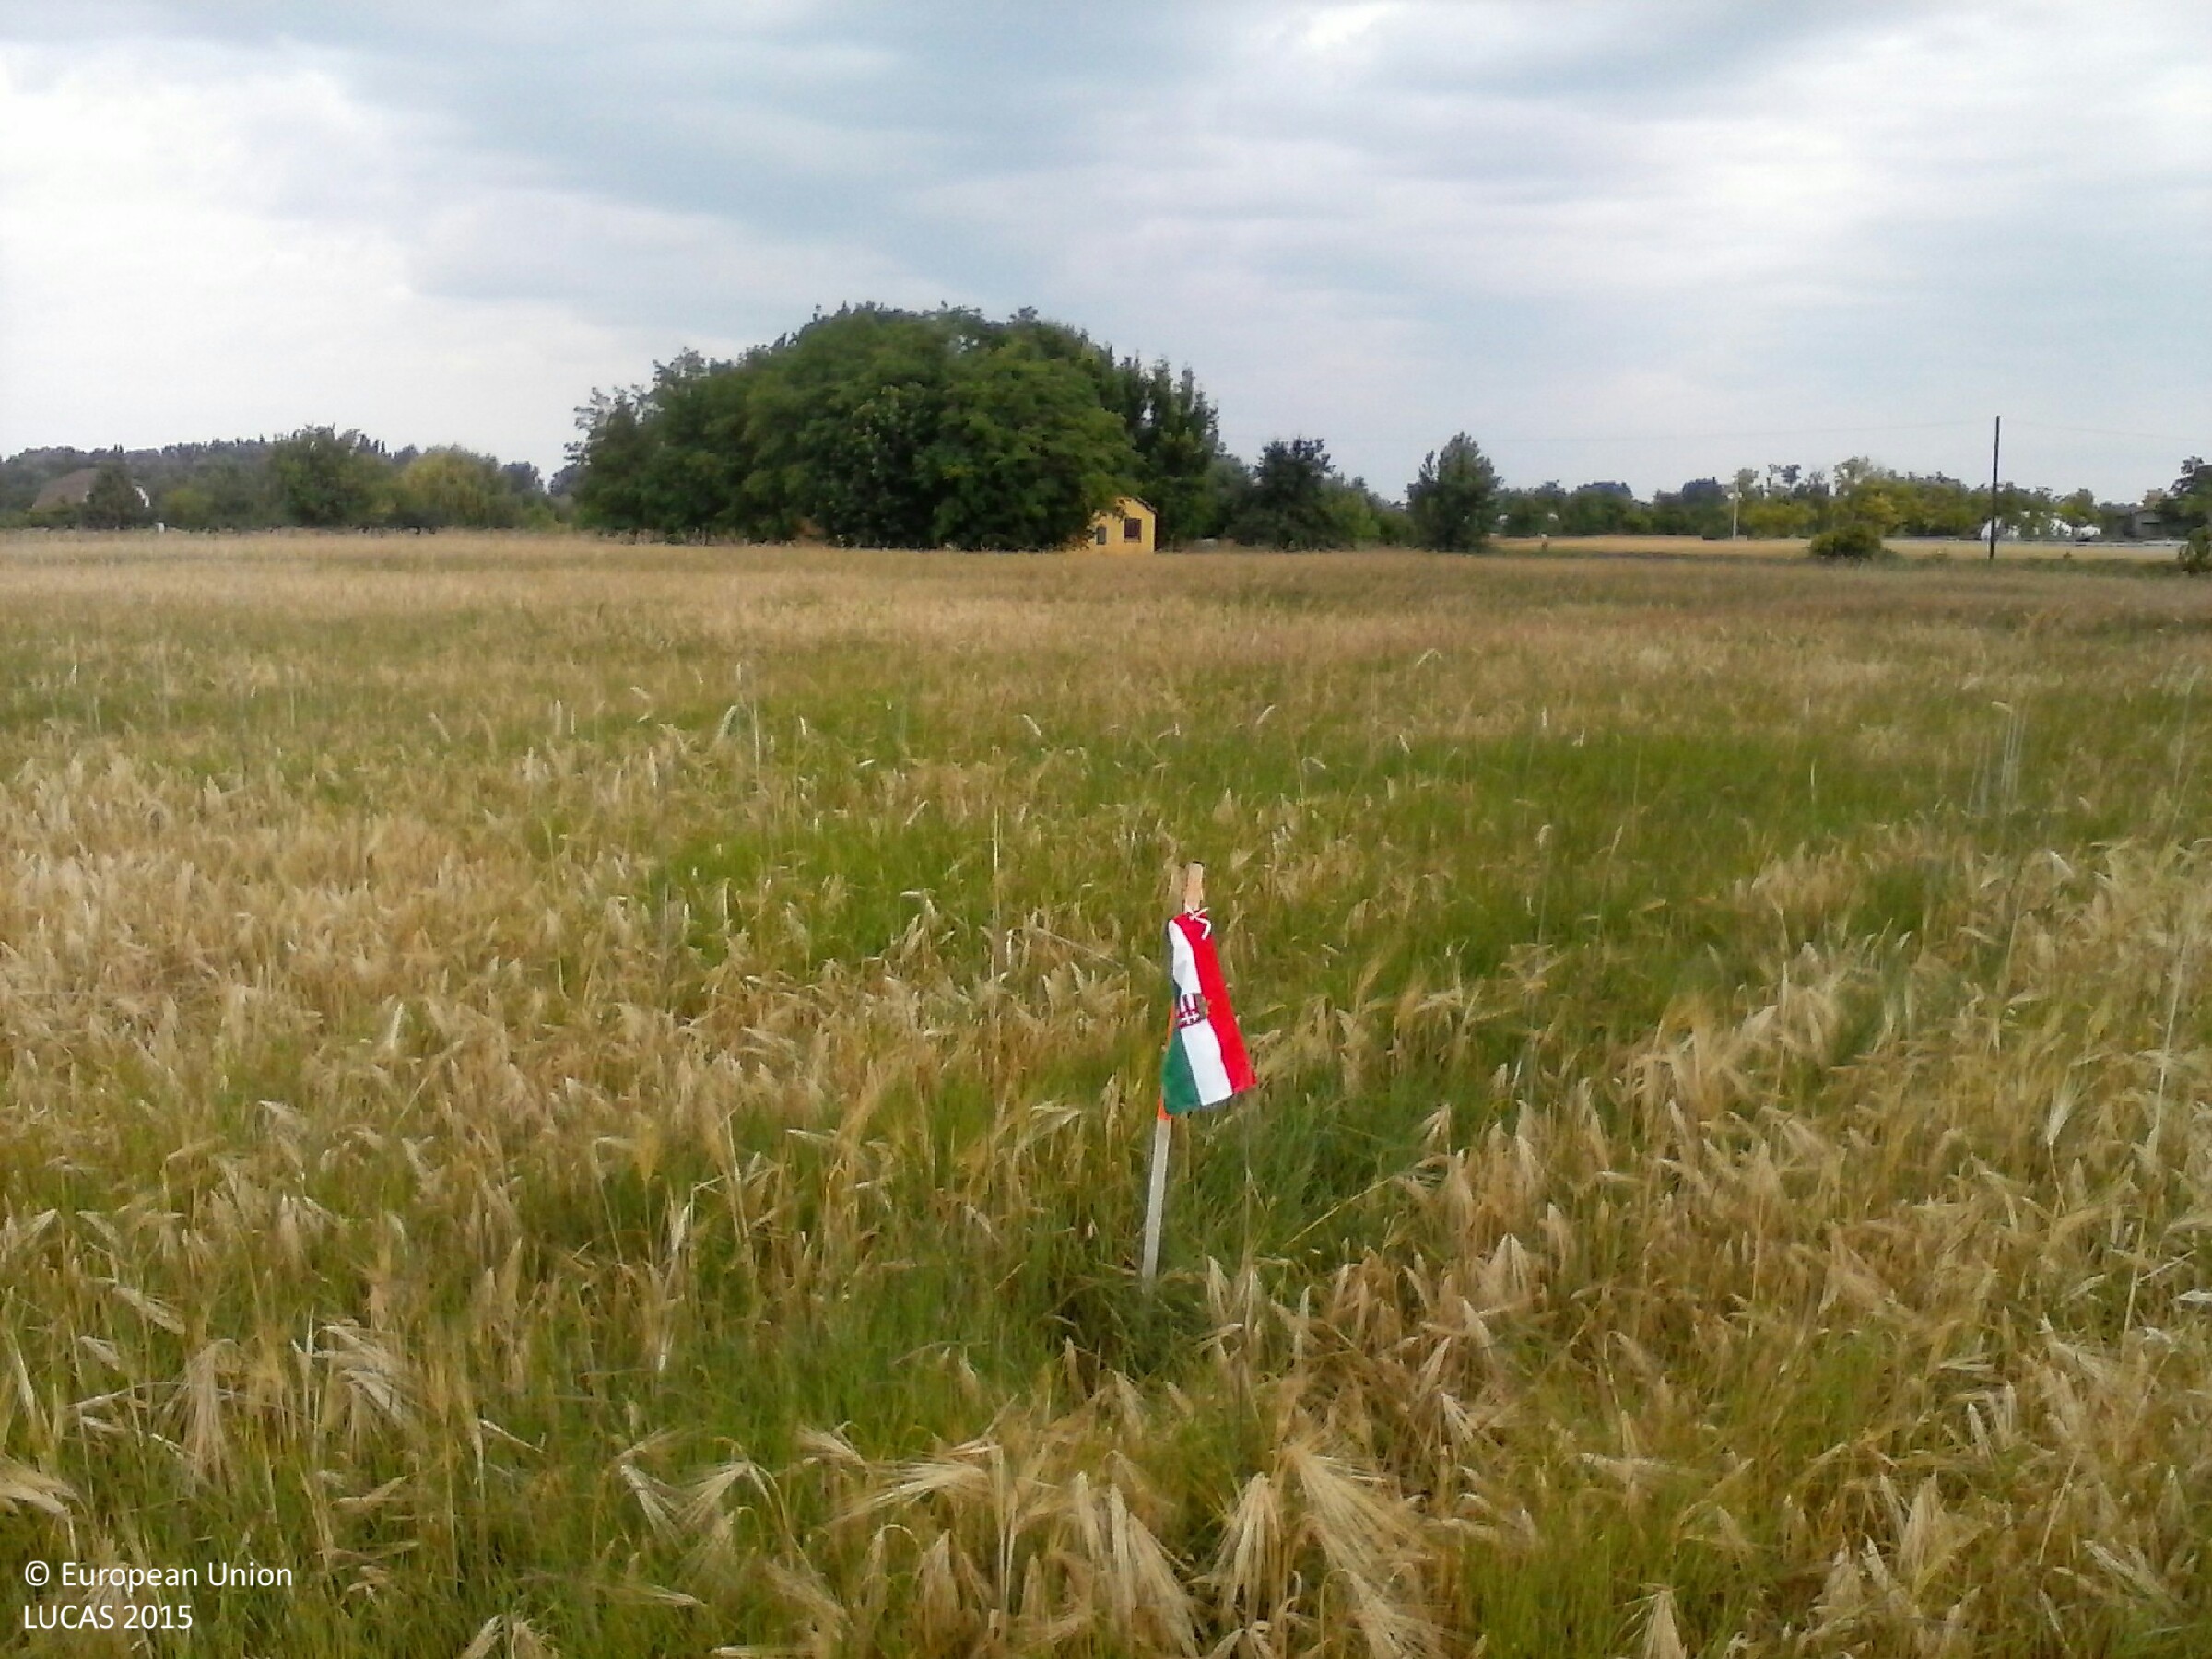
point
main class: Cropland
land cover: Barley
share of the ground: > 75 %
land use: Agriculture (excluding fallow land and kitchen gardens)
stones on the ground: < 10 %
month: June
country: HU
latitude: 46.3162
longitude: 20.0076
